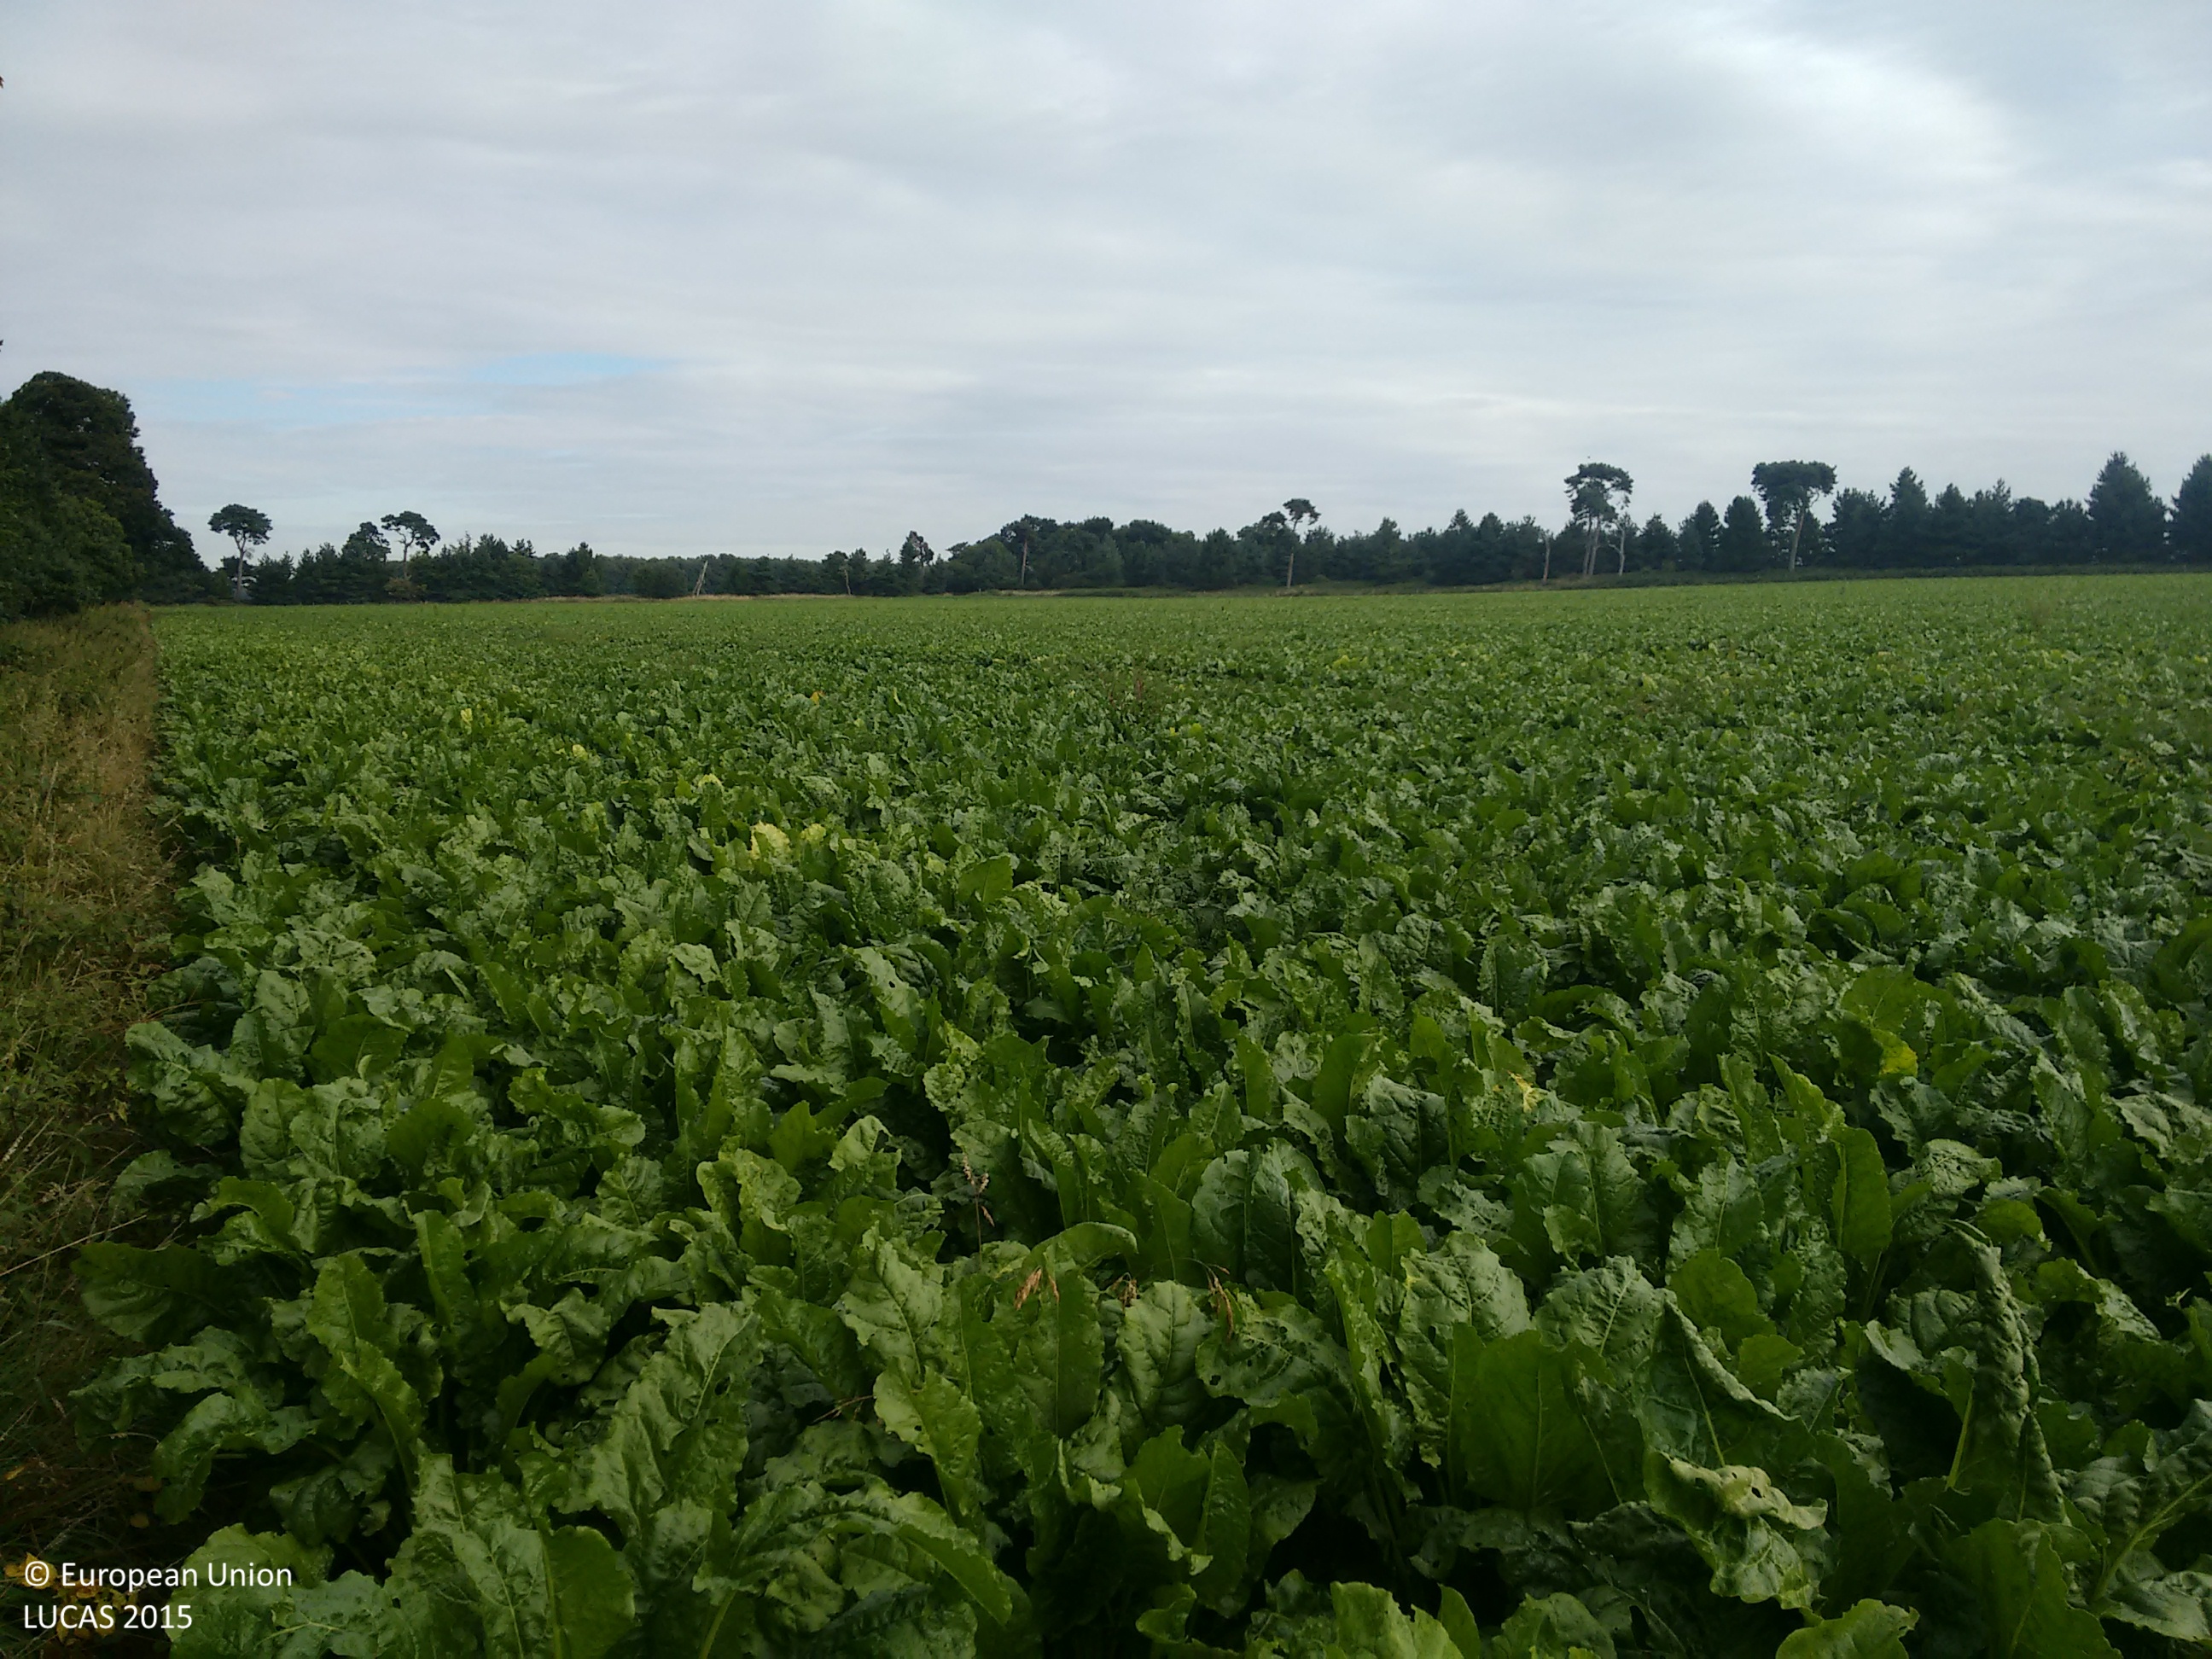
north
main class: Cropland
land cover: Sugar beet
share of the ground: > 75 %
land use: Agriculture (excluding fallow land and kitchen gardens)
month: August
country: GB
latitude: 52.0641
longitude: 1.3883
